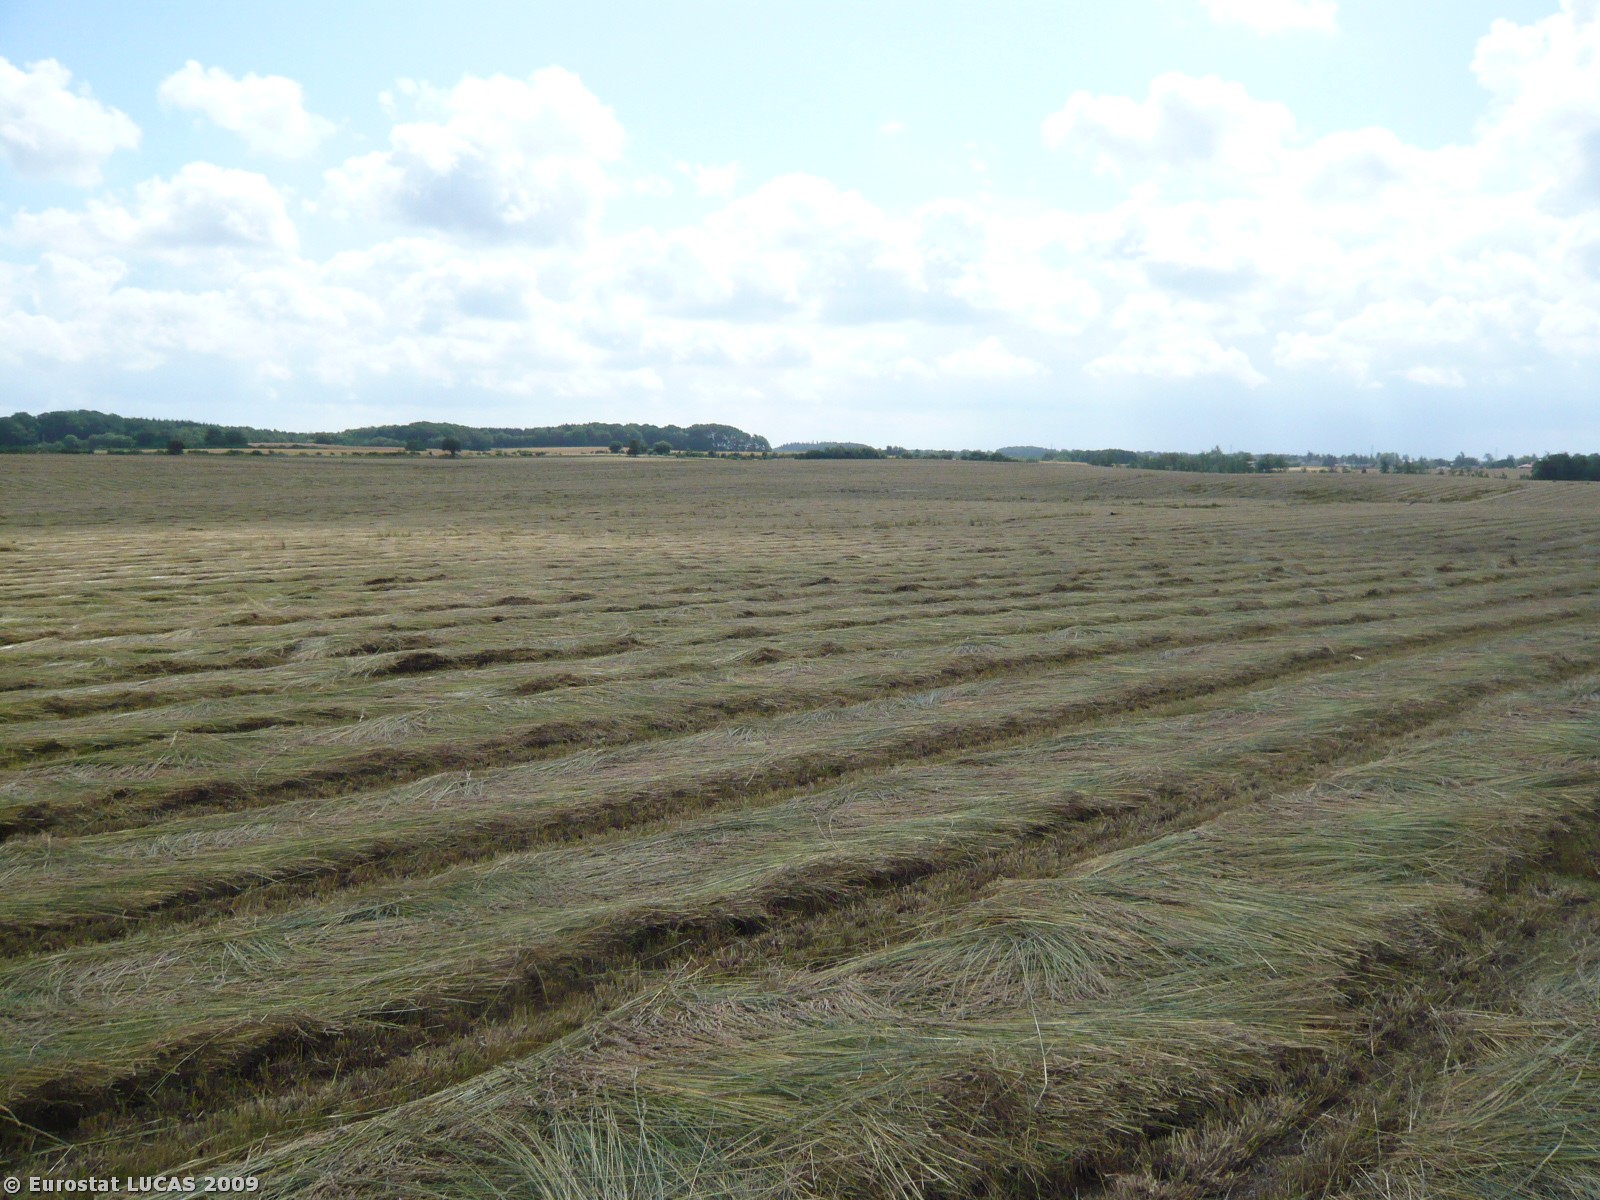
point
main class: Cropland
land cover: Temporary grasslands
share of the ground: > 75 %
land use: Agriculture (excluding fallow land and kitchen gardens)
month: July
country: DK
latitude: 55.4888
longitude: 12.0083
